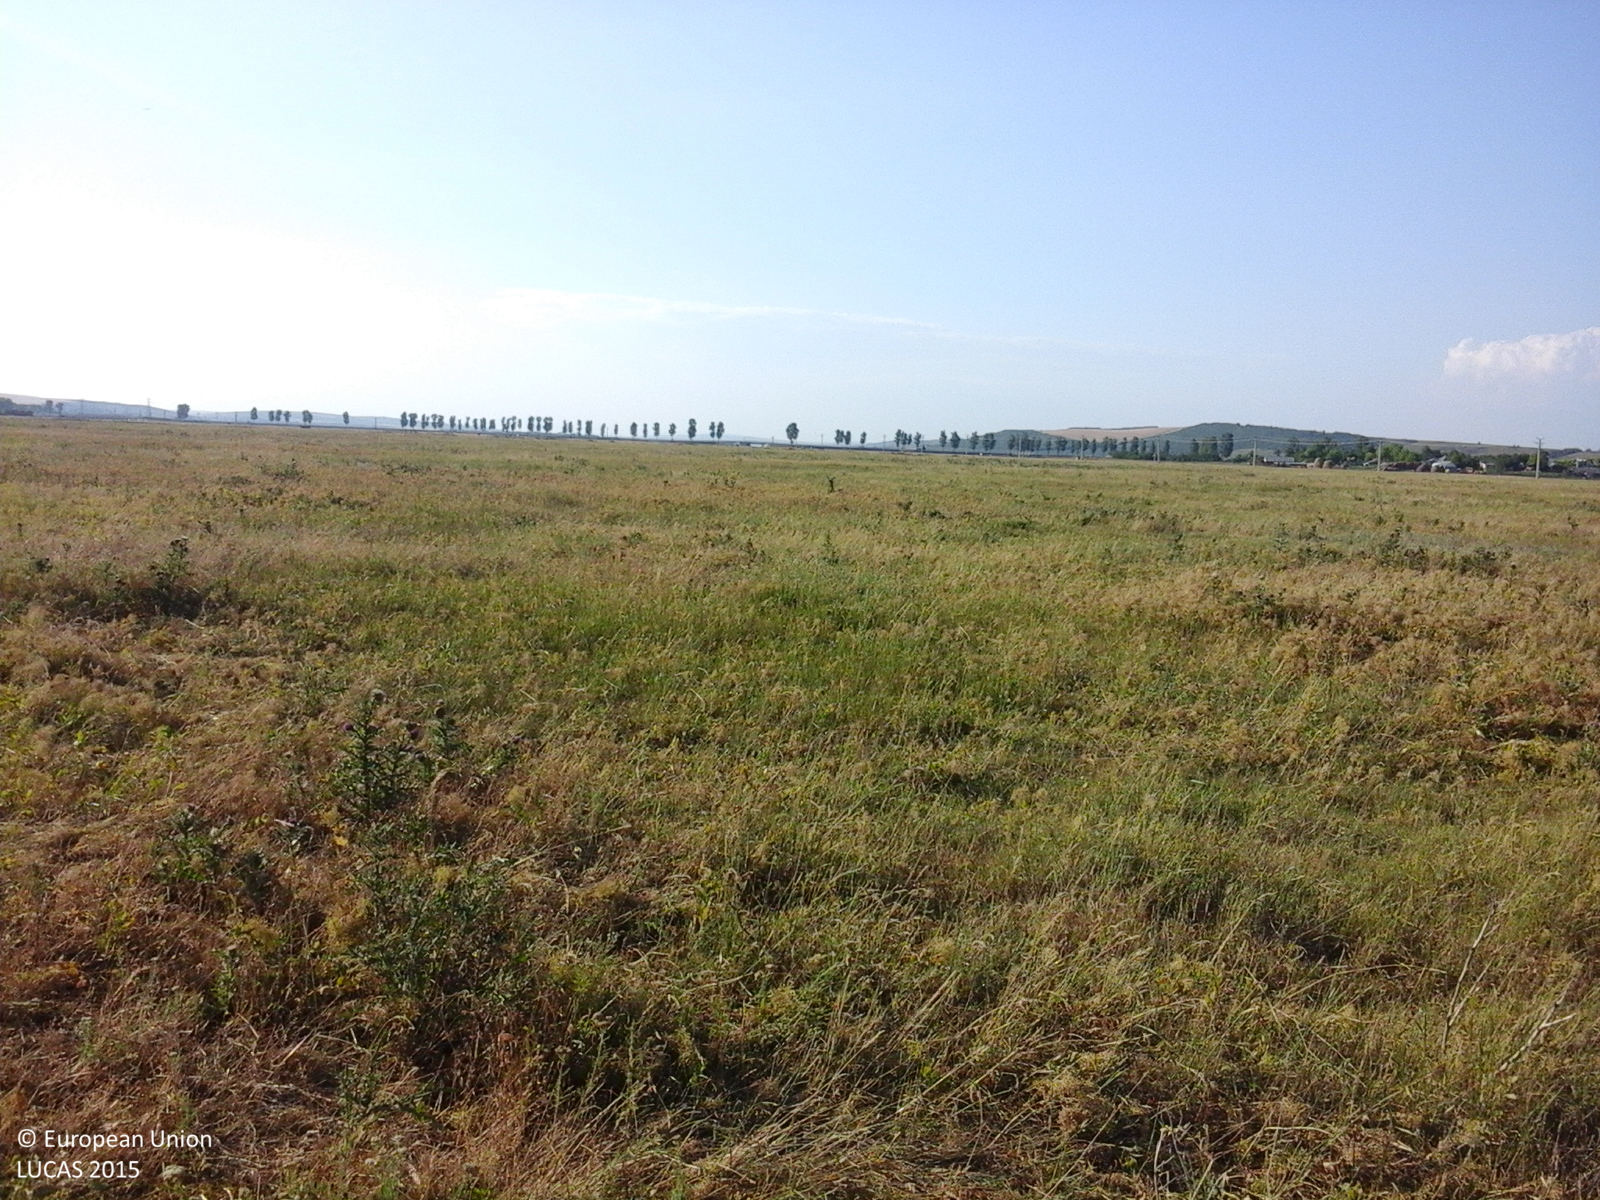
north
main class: Grassland
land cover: Grassland without tree/shrub cover
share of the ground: > 75 %
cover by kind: herbaceous plants 100 %
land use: Agriculture (excluding fallow land and kitchen gardens)
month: June
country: RO
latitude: 47.4036
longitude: 27.3526
